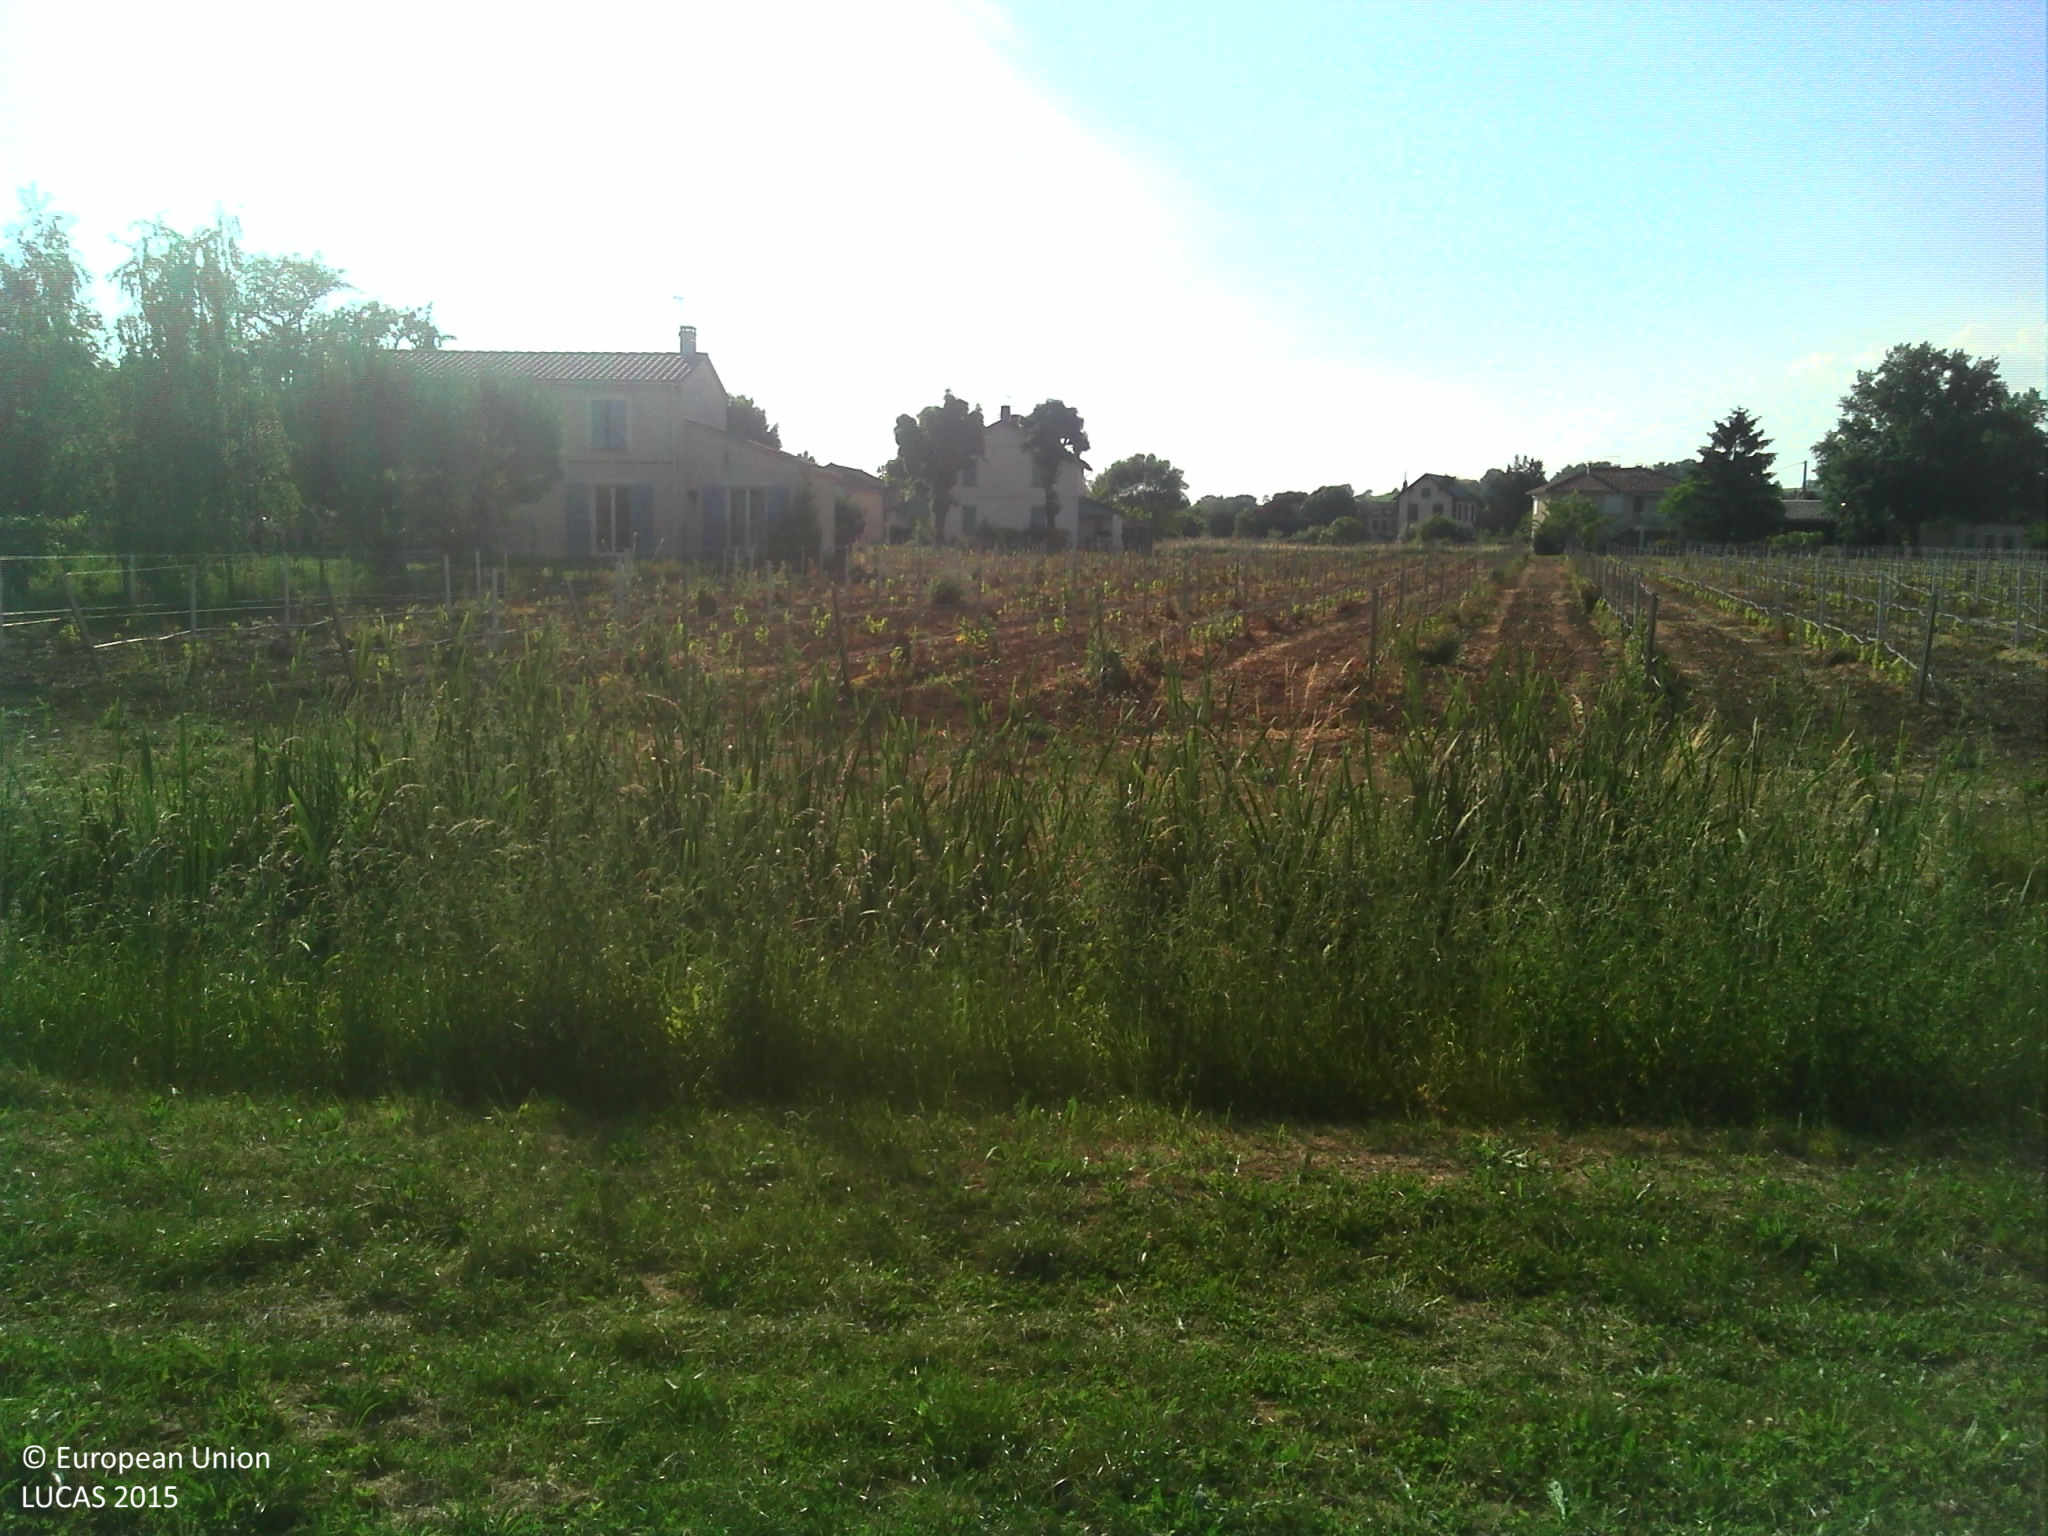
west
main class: Cropland
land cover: Vineyards
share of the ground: 10 - 25 %
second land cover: Spontaneously vegetated surfaces
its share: 25 - 50 %
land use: Agriculture (excluding fallow land and kitchen gardens)
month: June
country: FR
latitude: 43.9283
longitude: 1.9441
